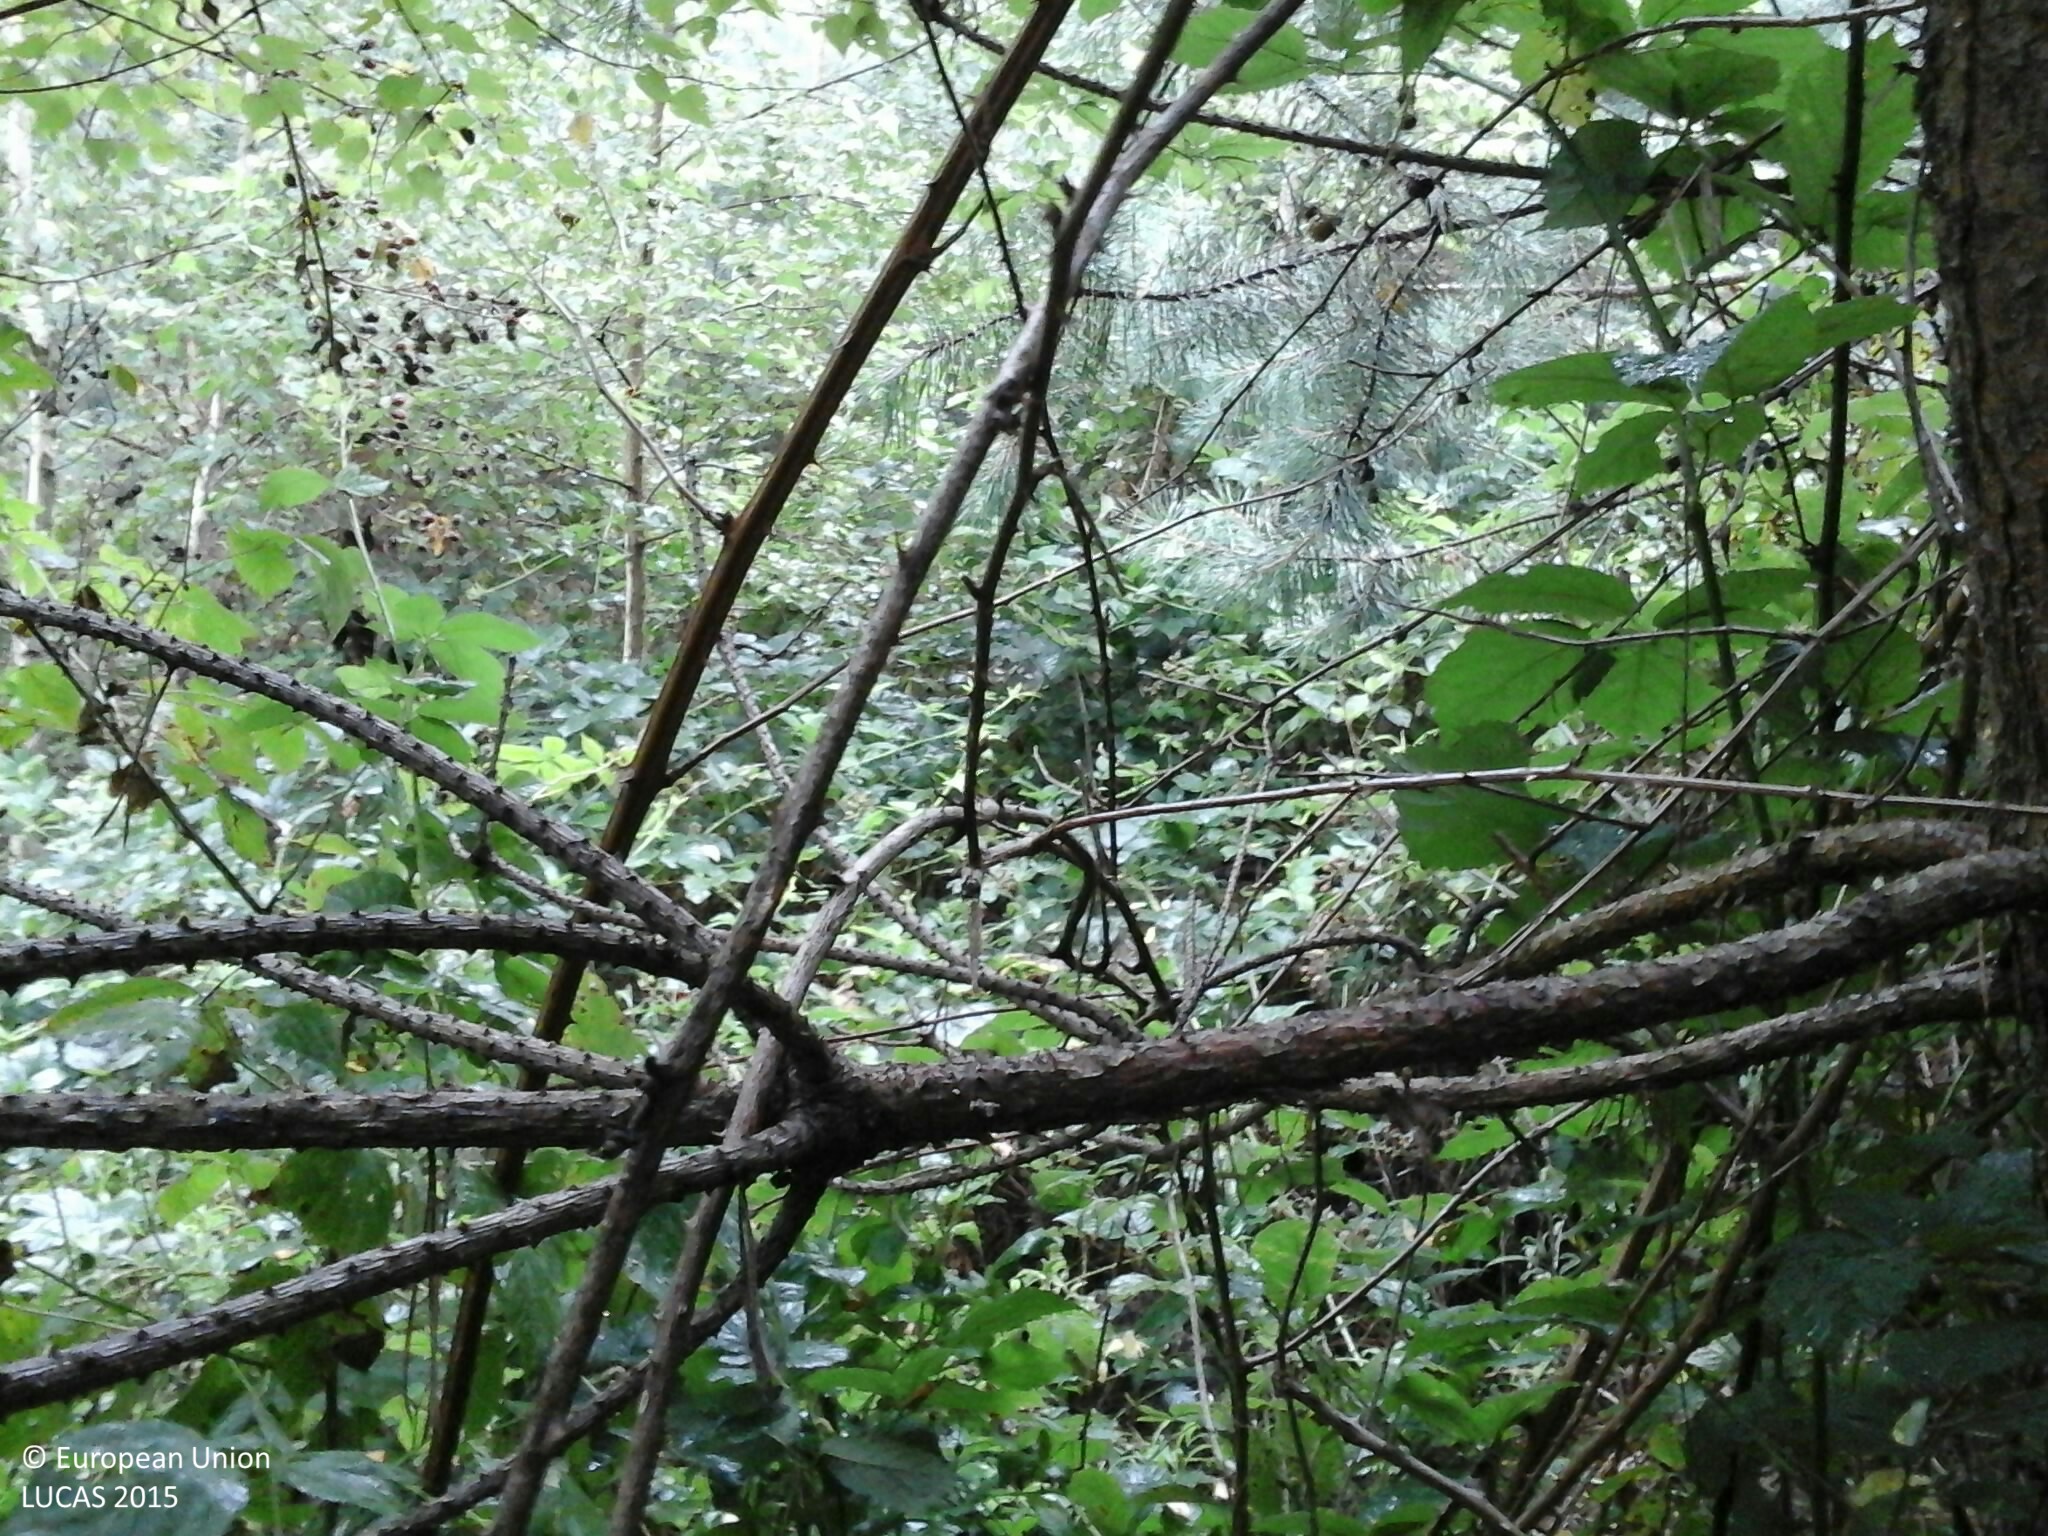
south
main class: Woodland
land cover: Pine dominated coniferous woodland
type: hemiboreal forest and nemoral coniferous forest and mixed broadleaved-coniferous forest
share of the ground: 50 - 75 %
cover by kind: coniferous forest trees 55 %, shrubs 20 %, broadleaved forest trees 15 %, herbaceous plants 10 %
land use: Forestry
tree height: < 5 m
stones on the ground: < 10 %
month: July
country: HU
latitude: 46.7866
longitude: 16.4860
